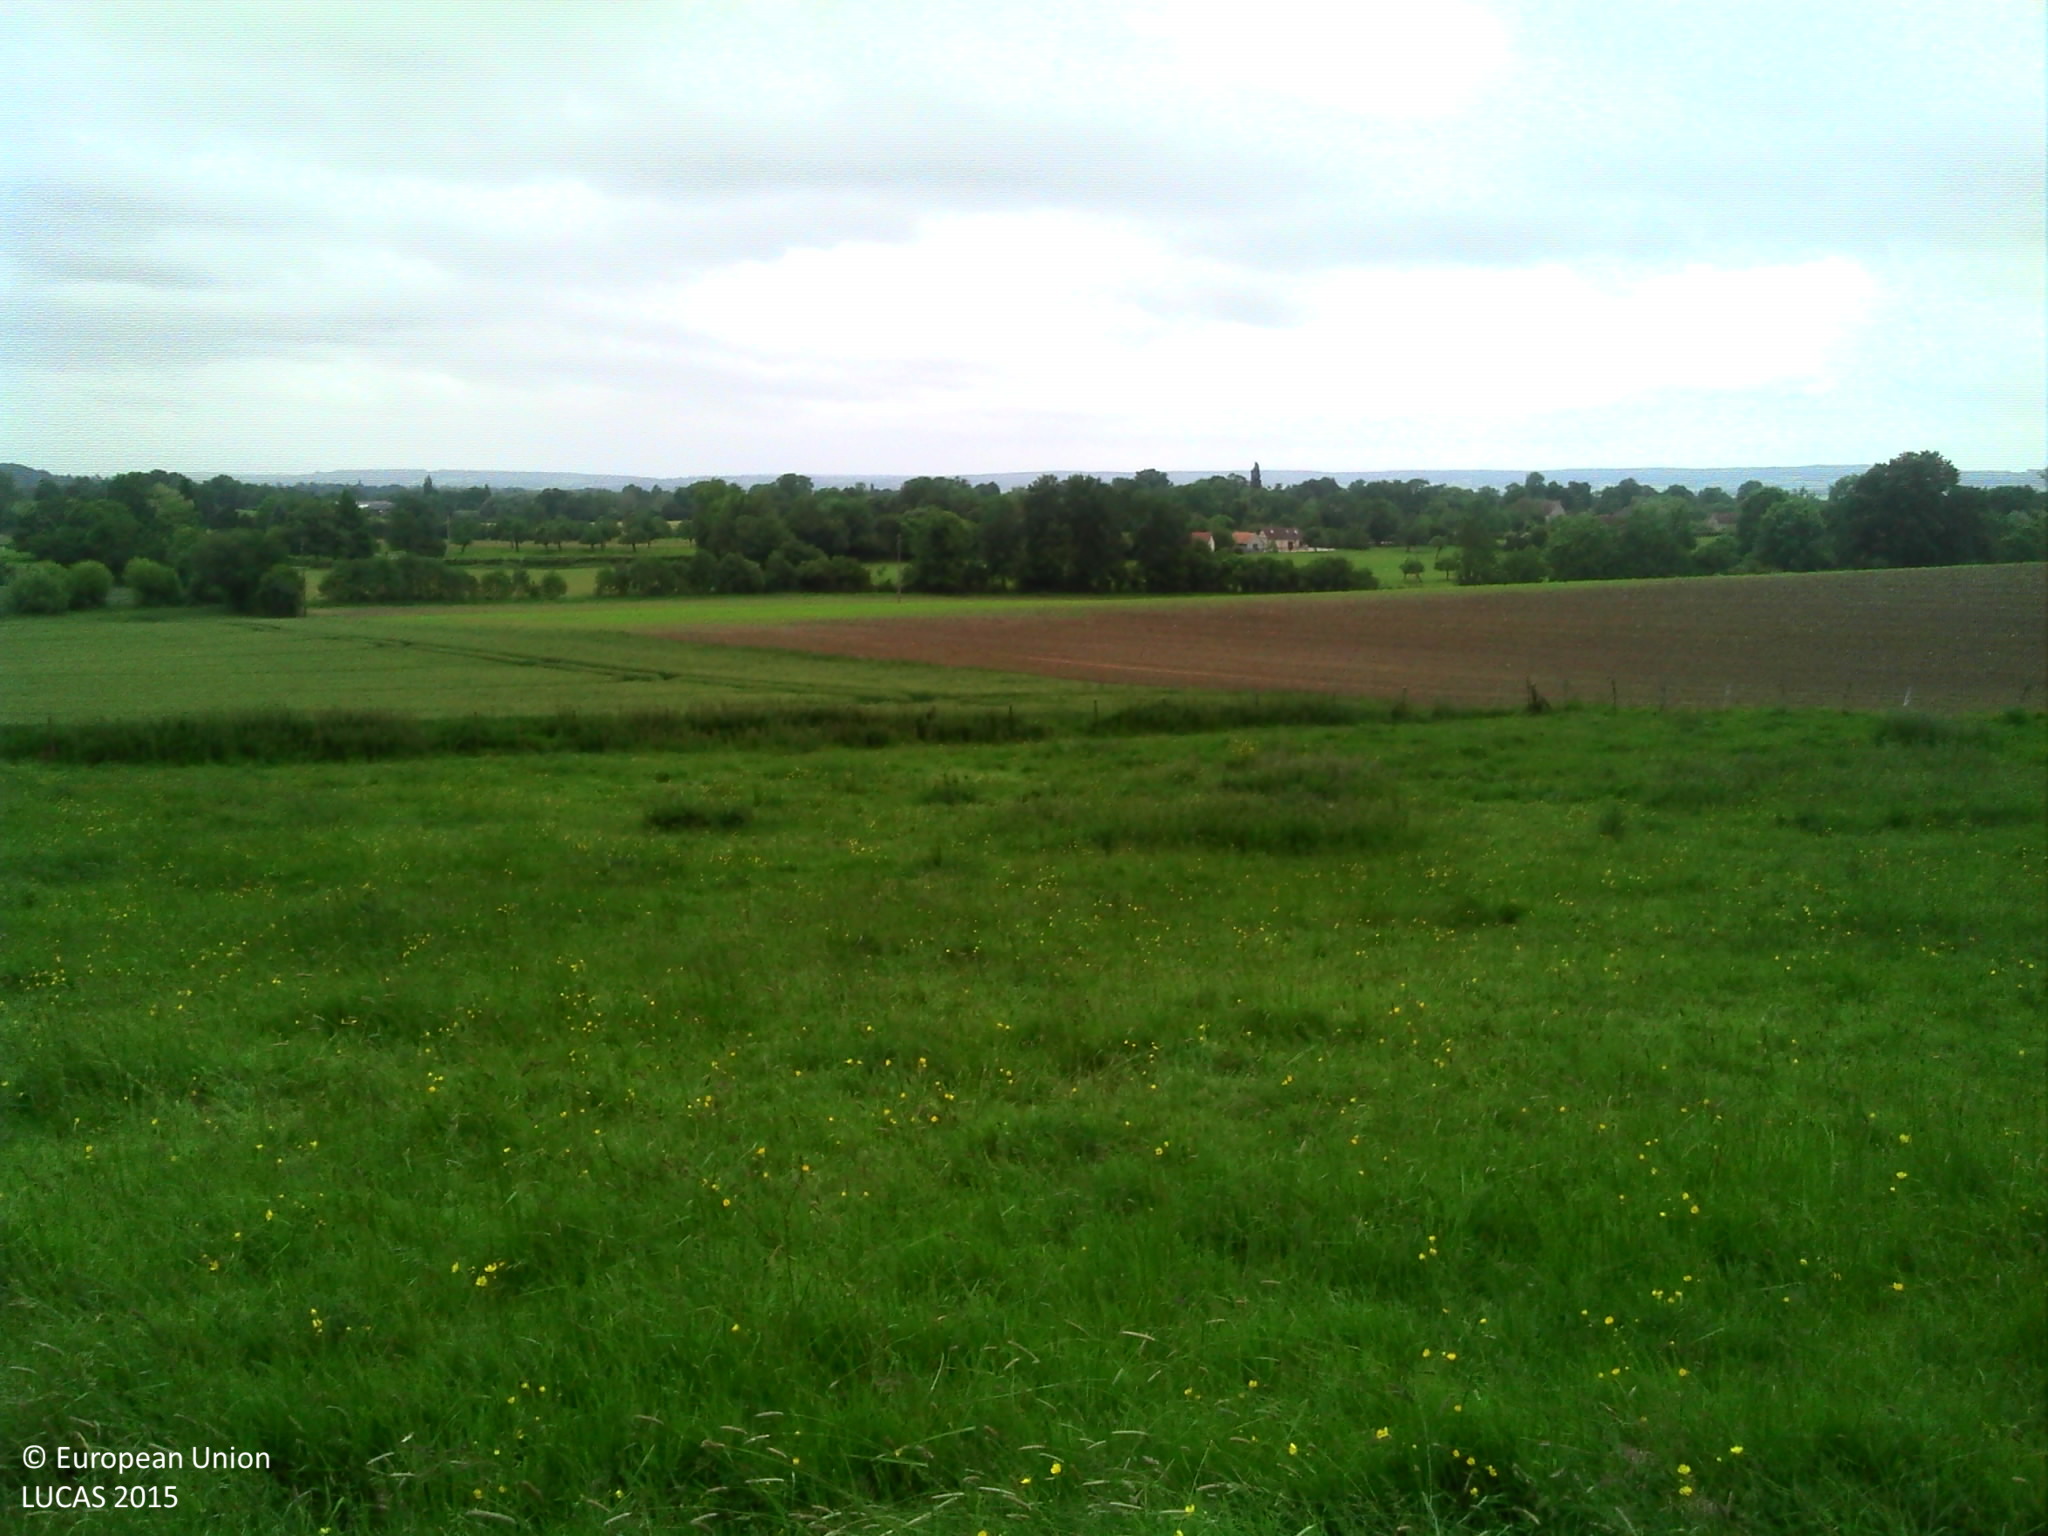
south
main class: Grassland
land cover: Grassland without tree/shrub cover
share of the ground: > 75 %
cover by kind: herbaceous plants 95 %, shrubs 5 %
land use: Agriculture (excluding fallow land and kitchen gardens)
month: June
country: FR
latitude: 48.8657
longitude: 0.1146
